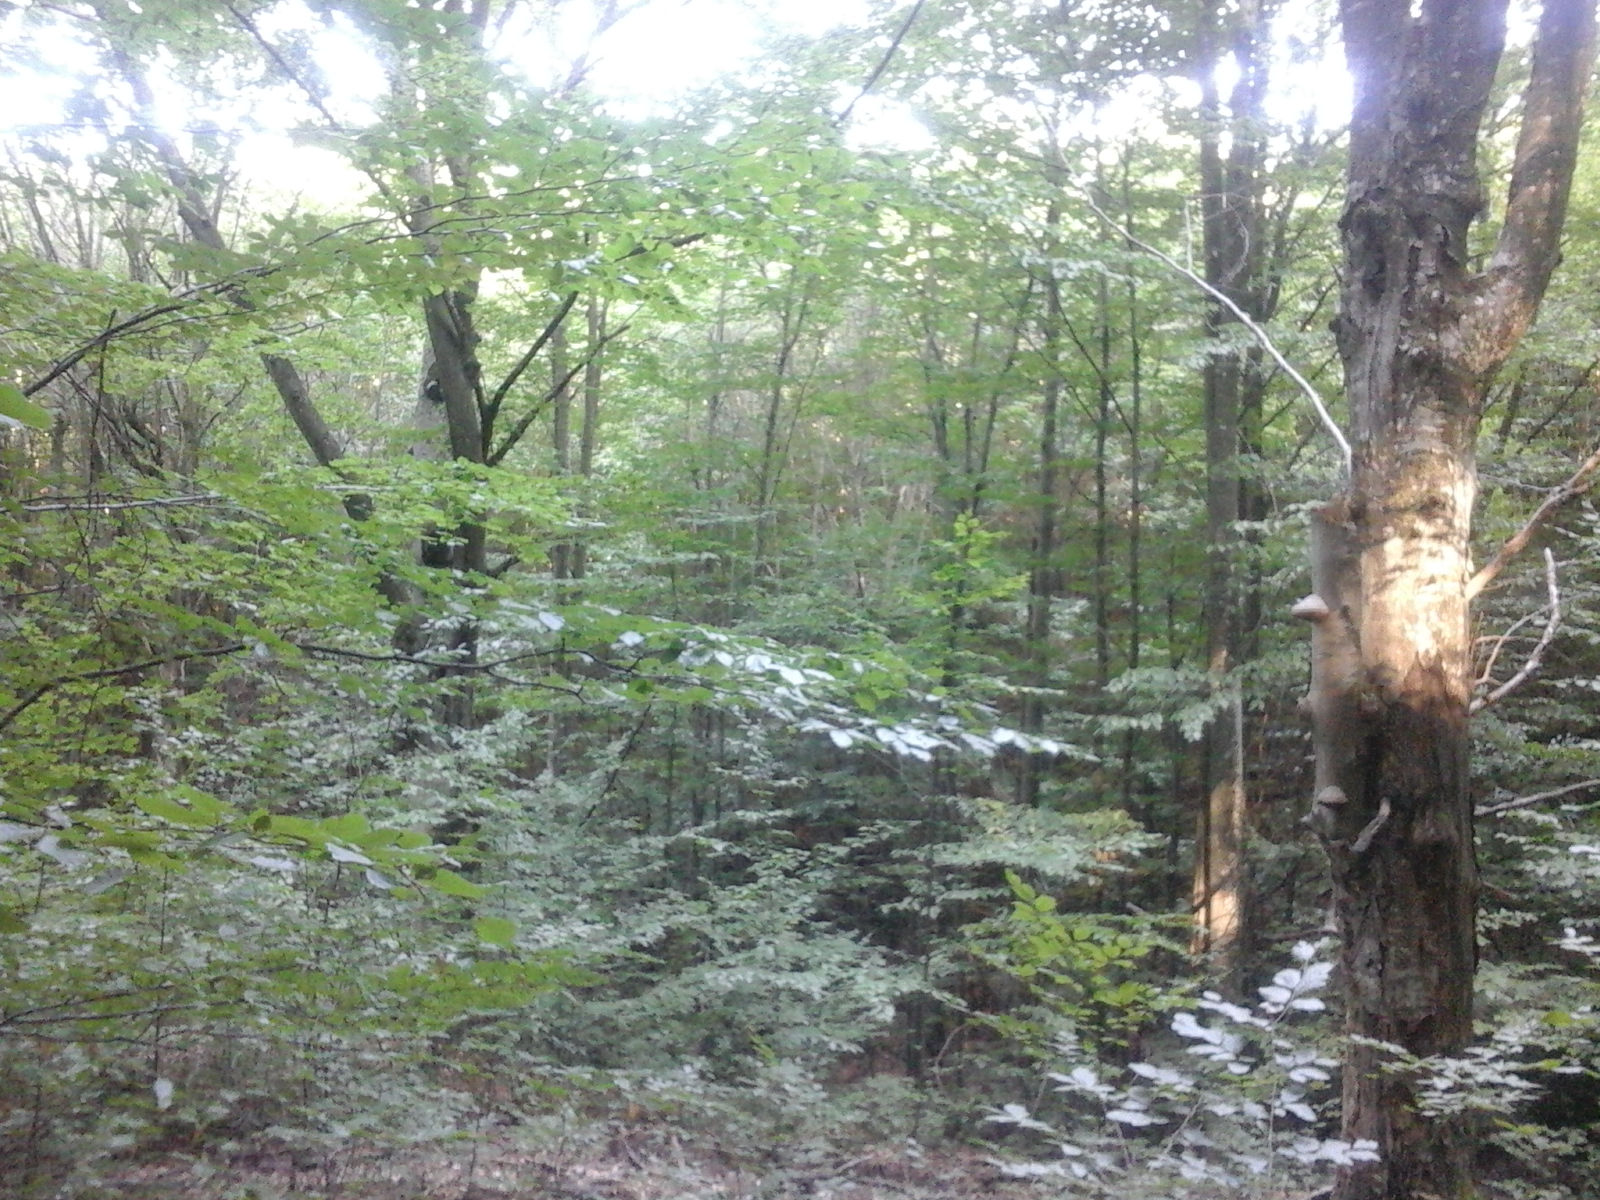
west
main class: Woodland
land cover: Broadleaved woodland
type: beech forest
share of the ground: > 75 %
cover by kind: broadleaved forest trees 100 %
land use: Forestry
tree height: > 5 m
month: September
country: RO
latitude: 47.4358
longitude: 23.5590
